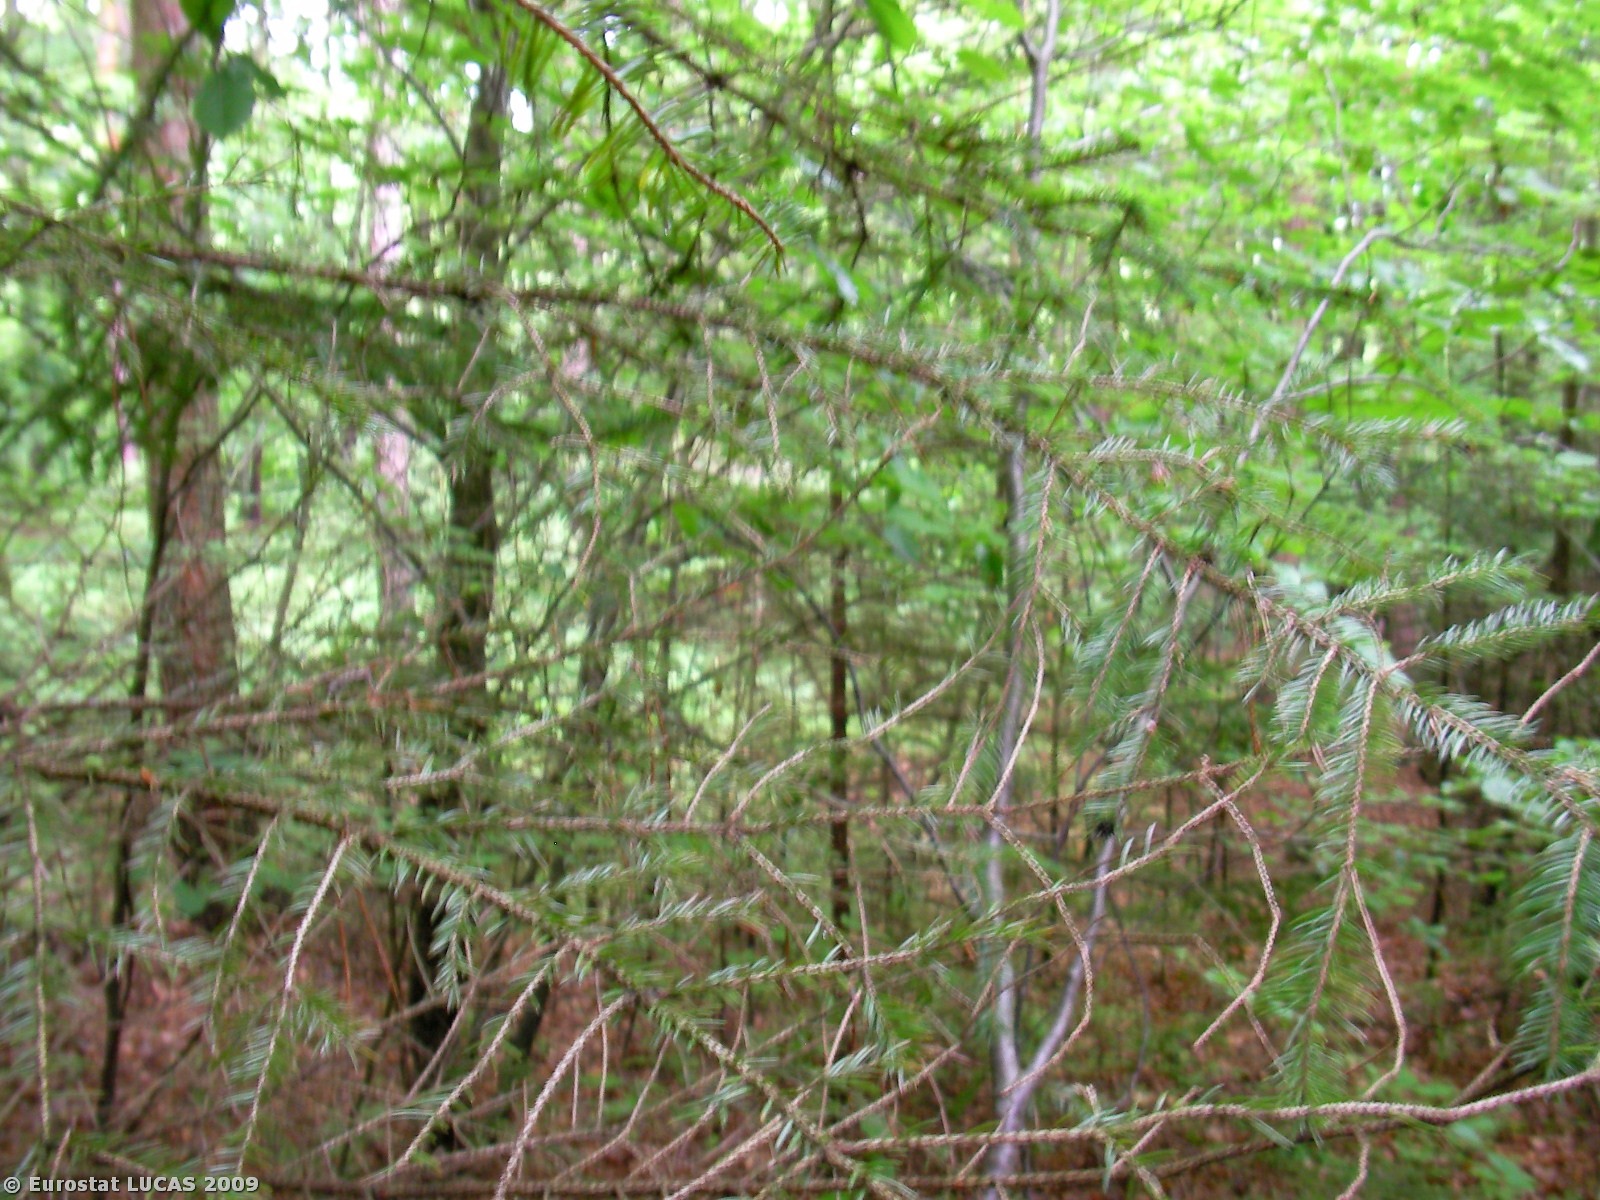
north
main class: Woodland
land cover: Coniferous woodland
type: hemiboreal forest and nemoral coniferous forest and mixed broadleaved-coniferous forest
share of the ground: > 75 %
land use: Forestry
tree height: > 5 m
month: June
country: AT
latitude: 47.1898
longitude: 15.7419
